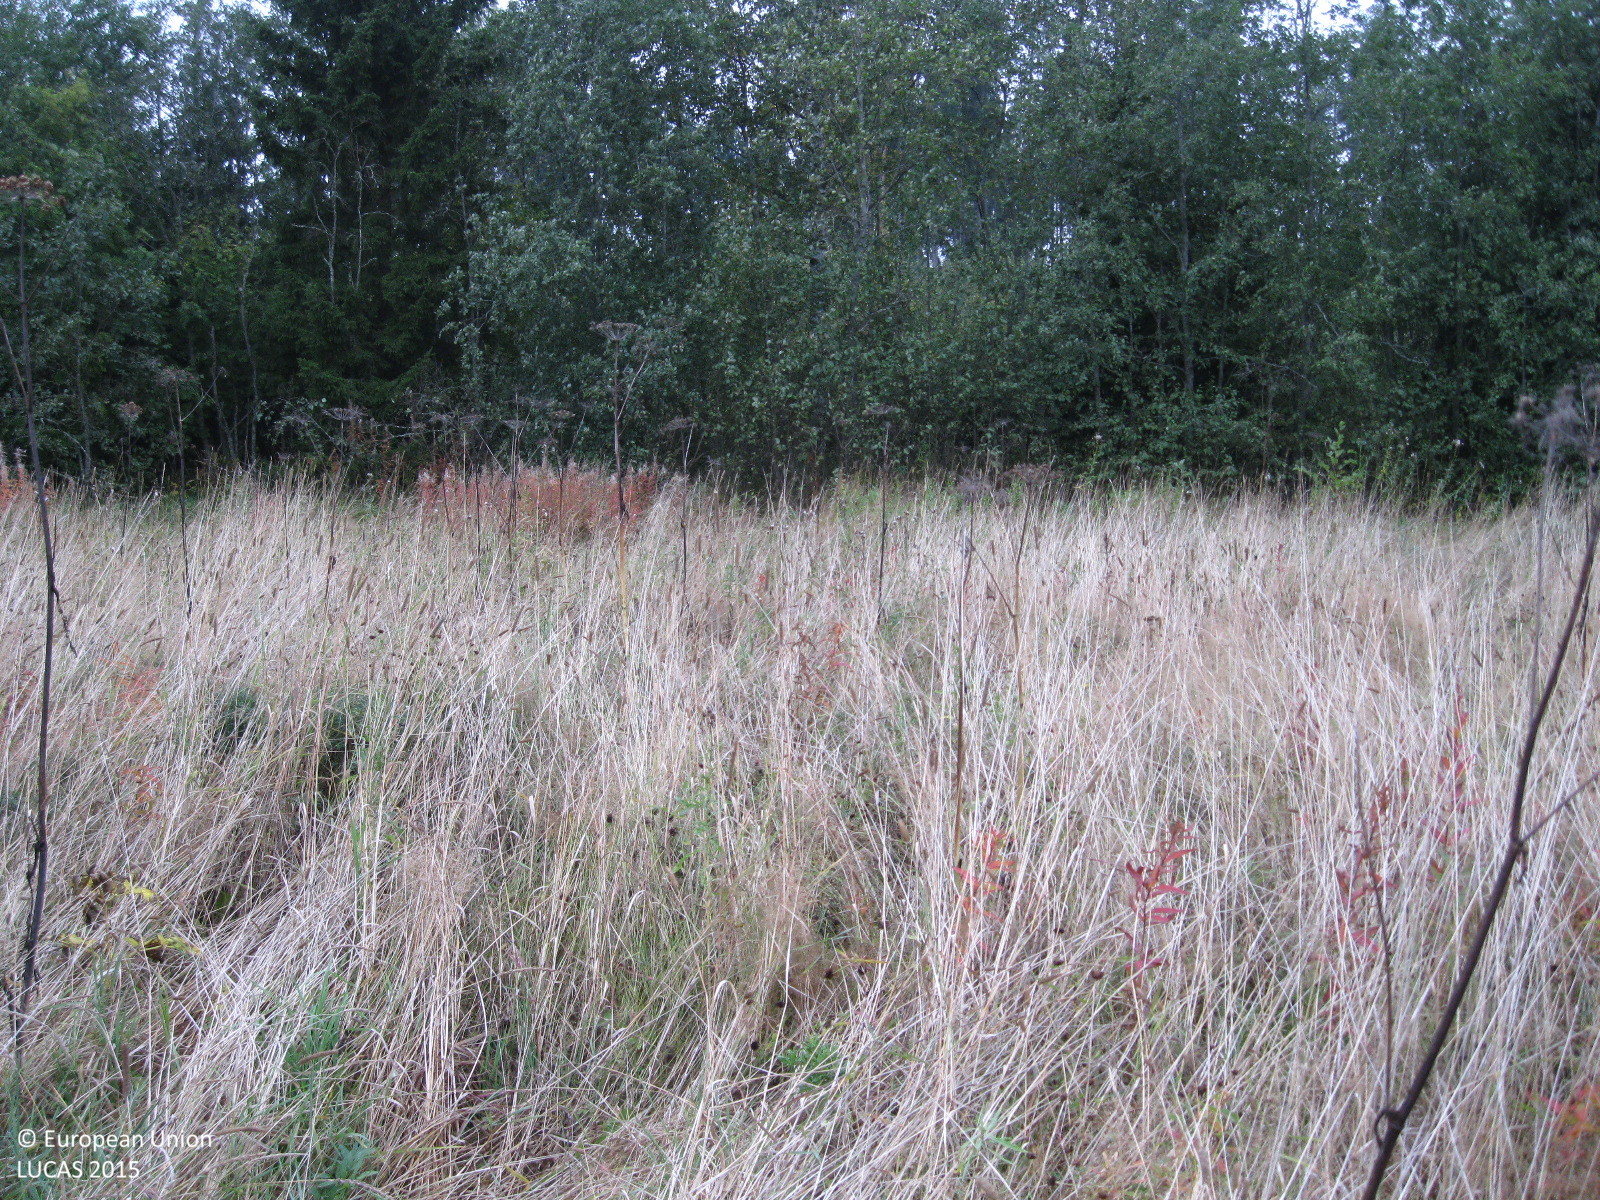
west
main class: Grassland
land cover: Spontaneously vegetated surfaces
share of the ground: > 75 %
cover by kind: herbaceous plants 100 %
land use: Fallow land
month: September
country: FI
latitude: 60.8712
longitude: 24.9006
